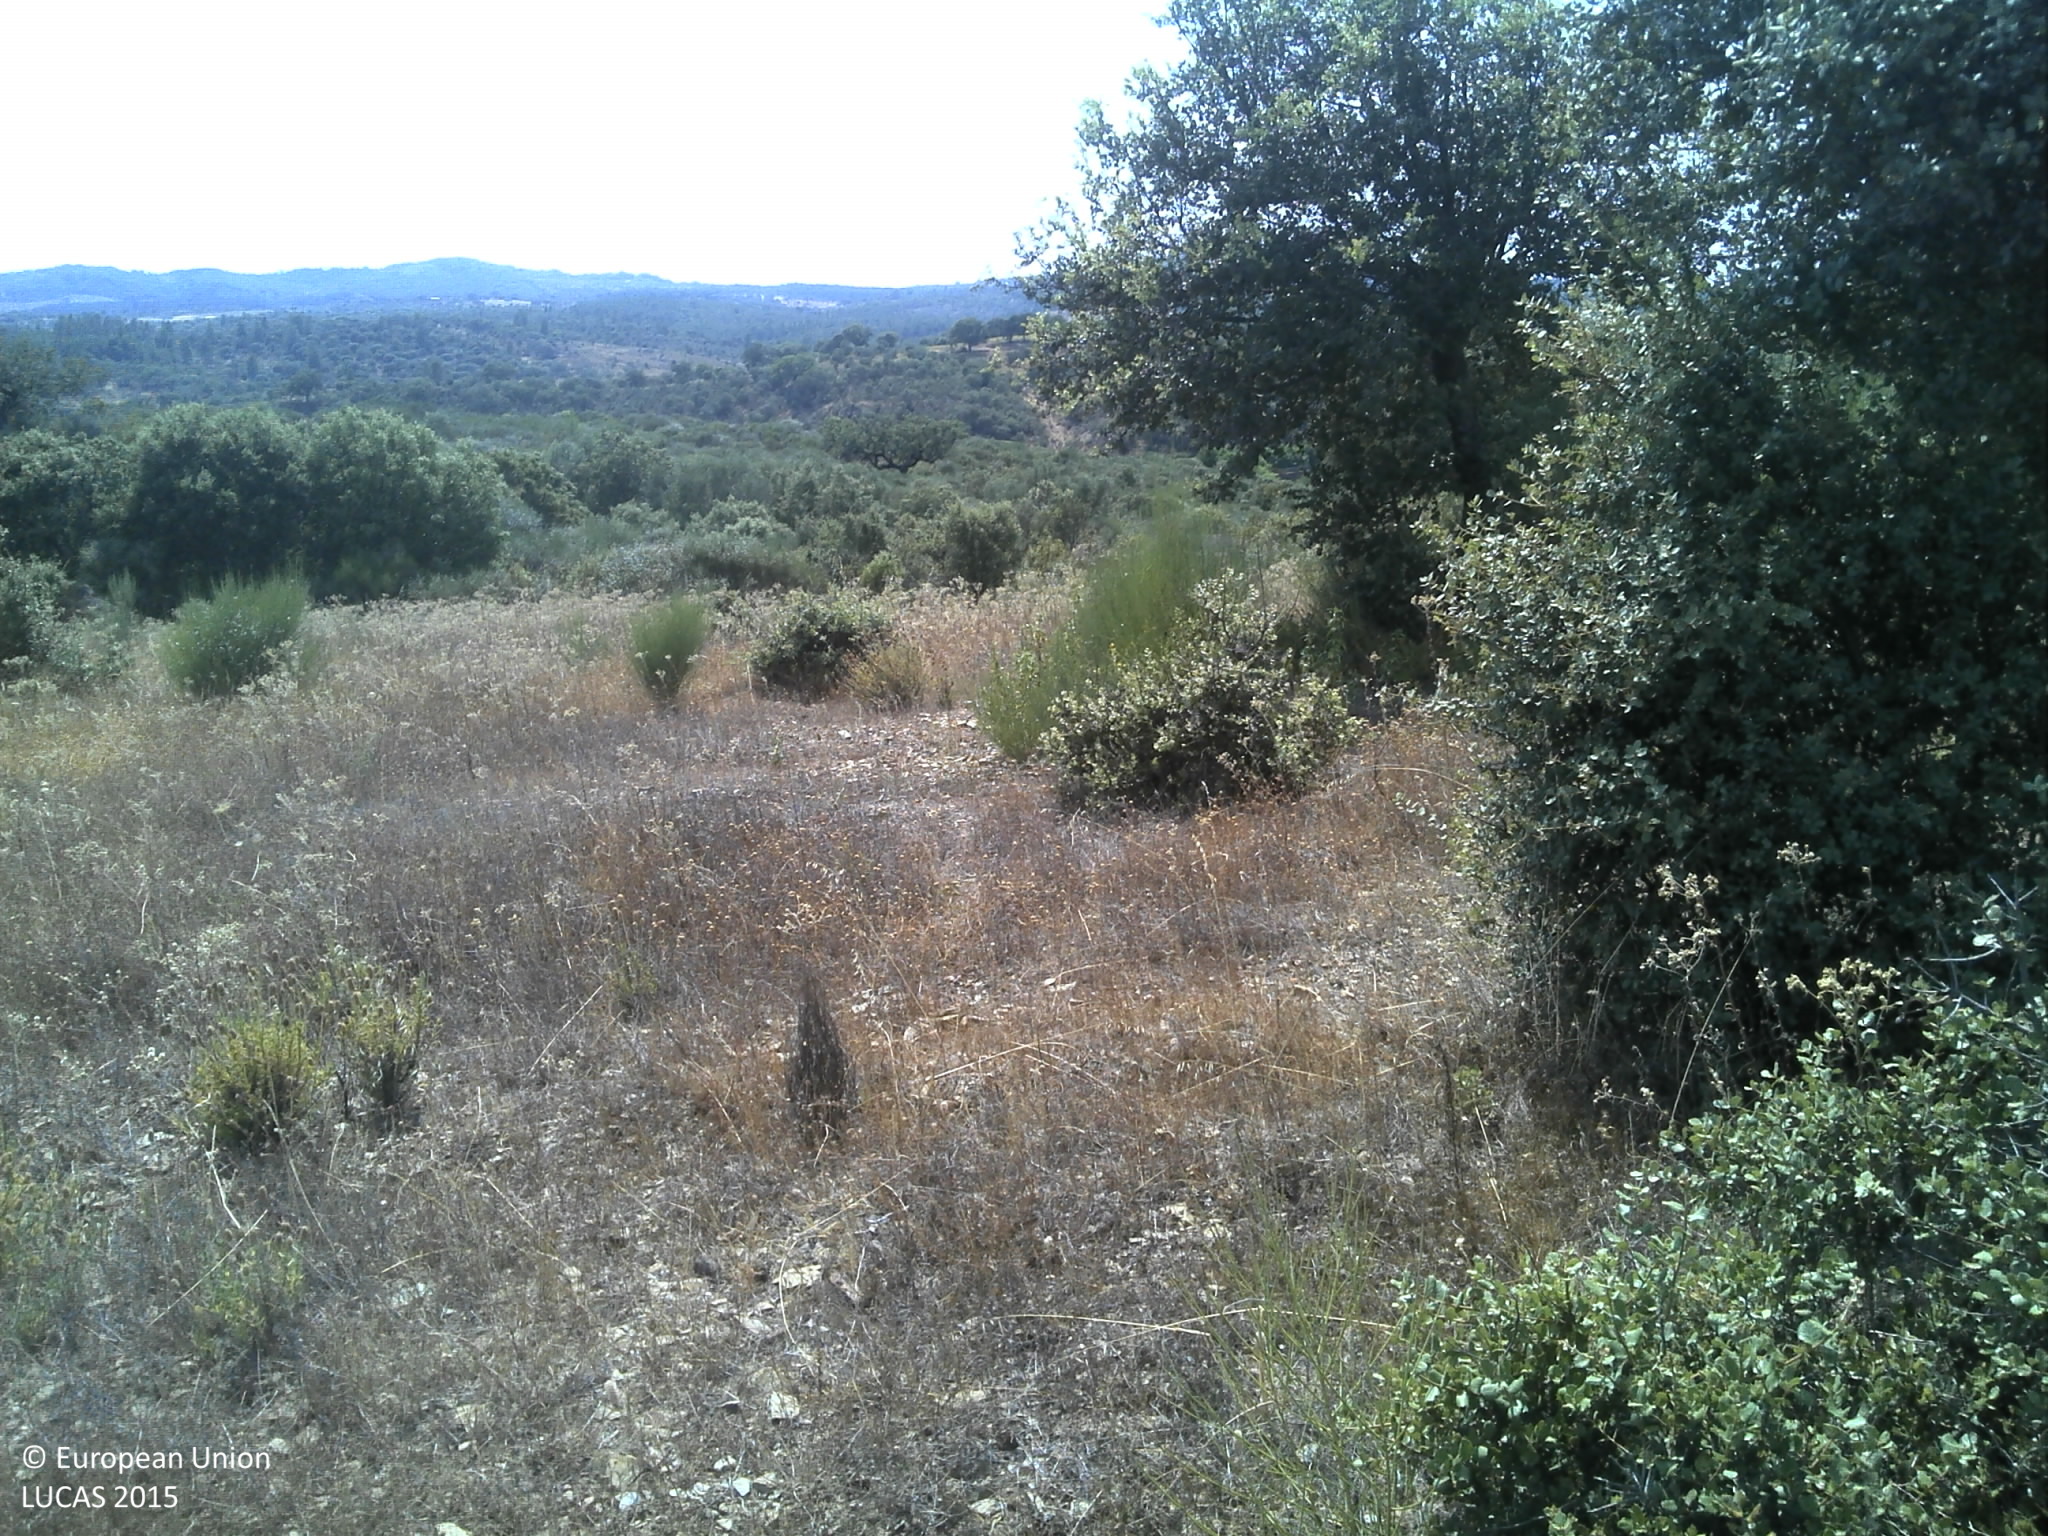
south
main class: Grassland
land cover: Grassland with sparse tree/shrub cover
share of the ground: 25 - 50 %
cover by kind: herbaceous plants 45 %, unconsolidated bare surface 40 %, broadleaved forest trees 5 %, shrubs 5 %
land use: Agriculture (excluding fallow land and kitchen gardens)
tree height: > 5 m
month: June
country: PT
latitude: 40.1404
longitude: -7.0786
